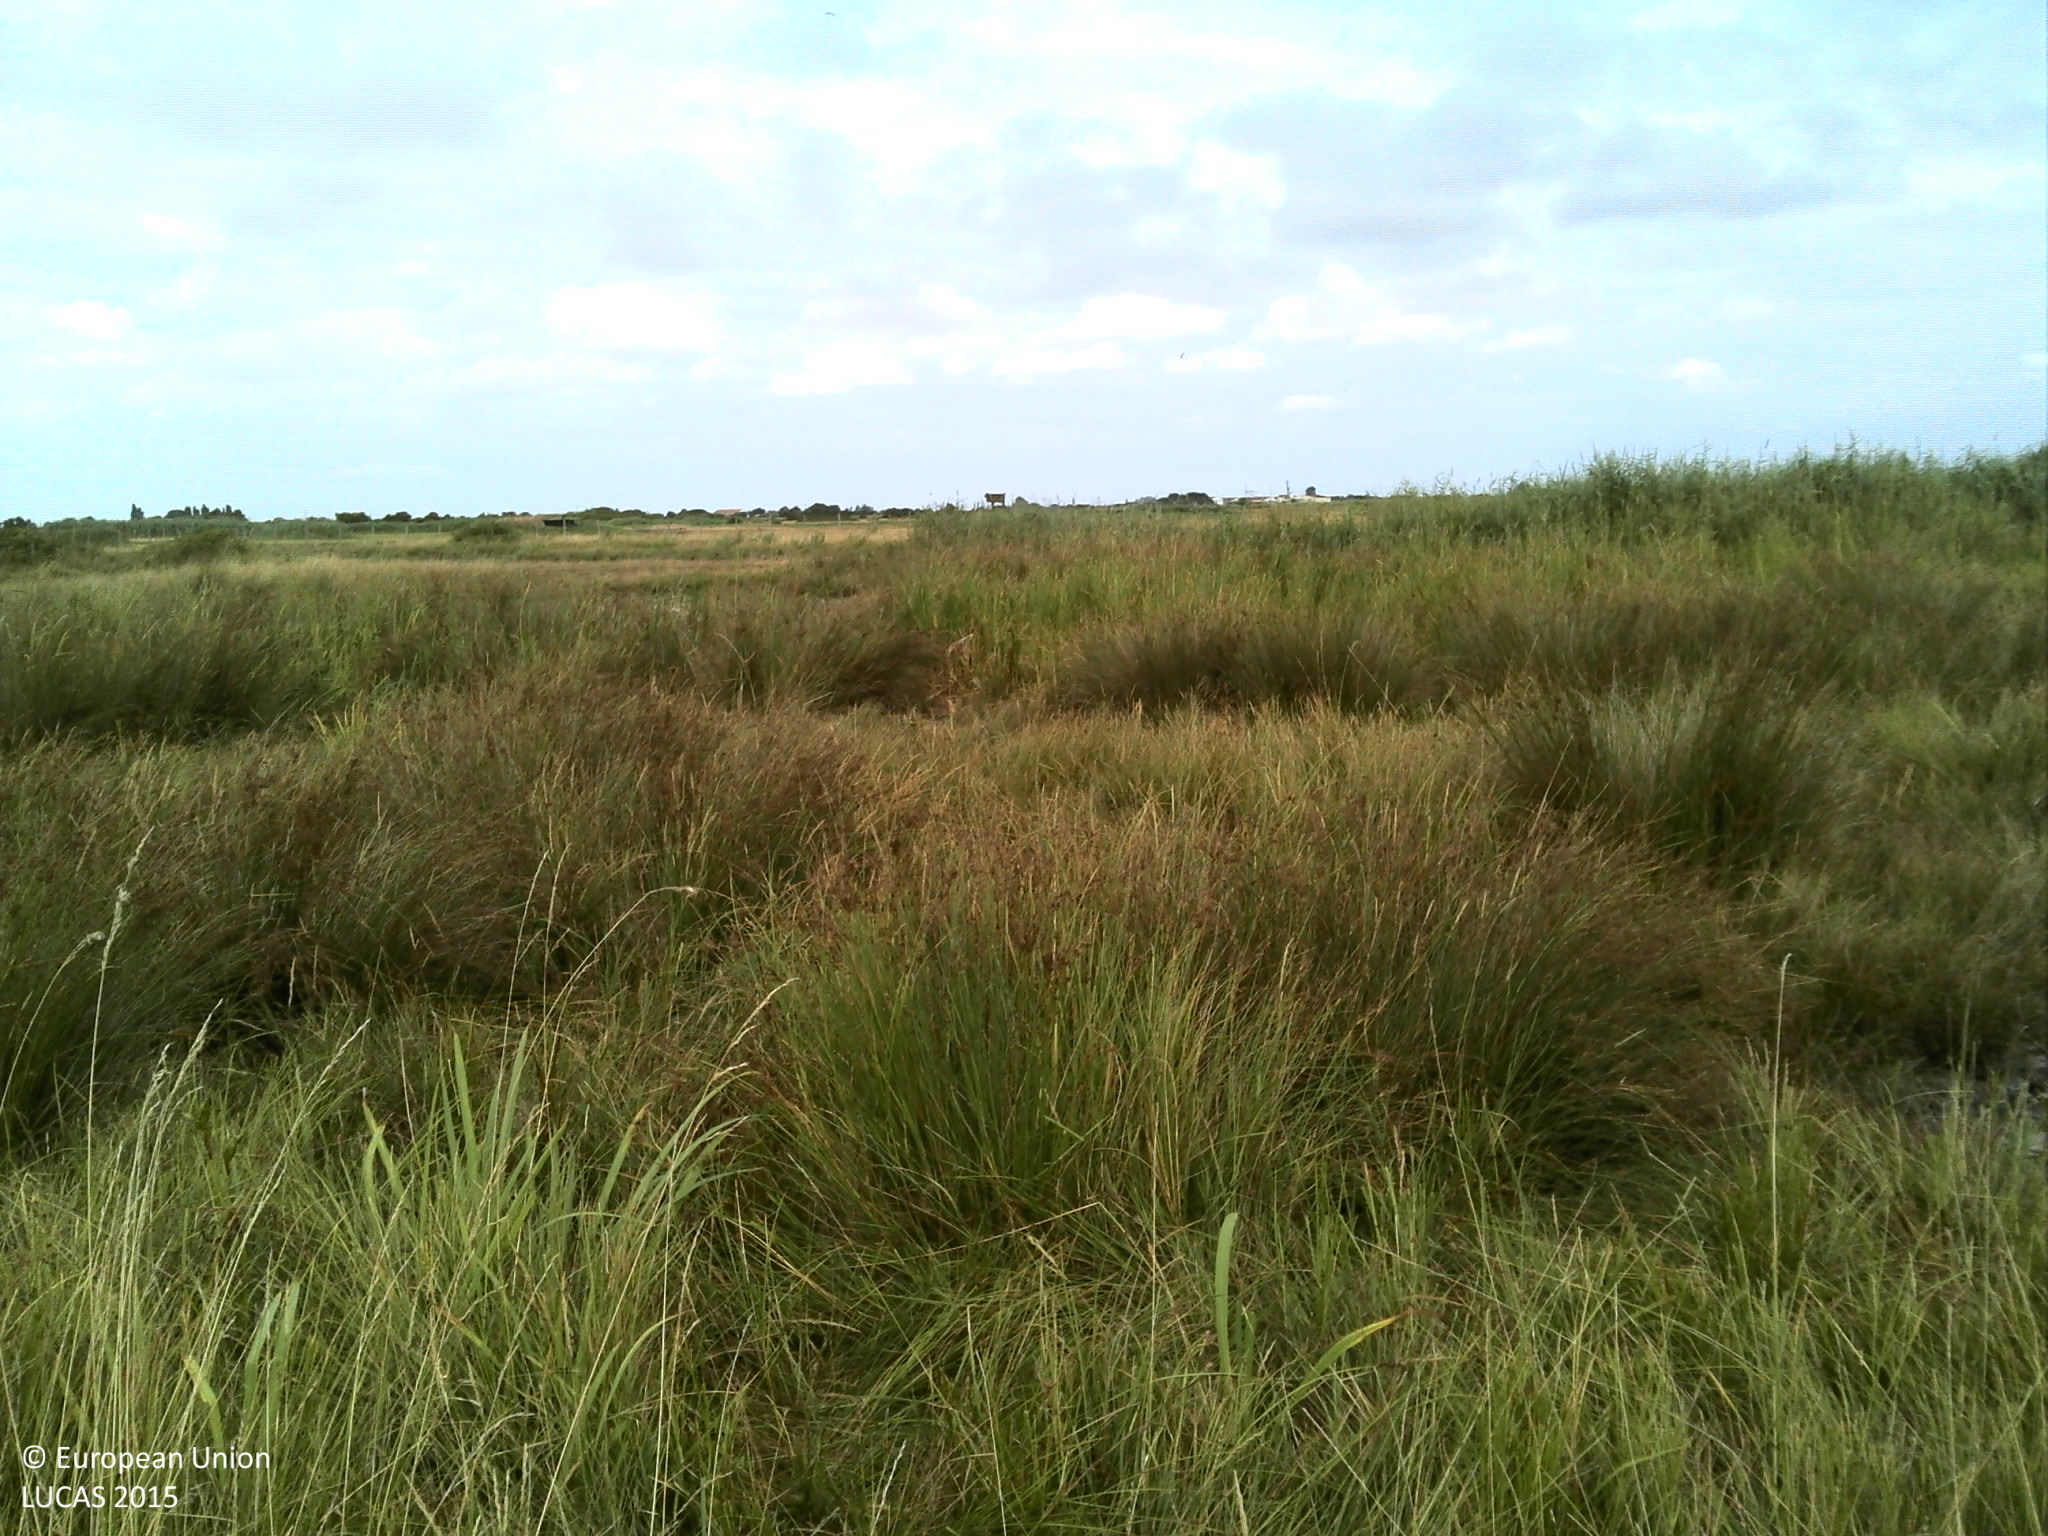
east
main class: Grassland
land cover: Grassland without tree/shrub cover
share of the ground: > 75 %
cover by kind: herbaceous plants 100 %
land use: Agriculture (excluding fallow land and kitchen gardens)
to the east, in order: Grassland without tree/shrub cover; Other bare soil; Grassland without tree/shrub cover; Tracks; Inland marshes; Grassland without tree/shrub cover; Fences; Grassland without tree/shrub cover
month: July
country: FR
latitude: 45.4992
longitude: -1.0975
